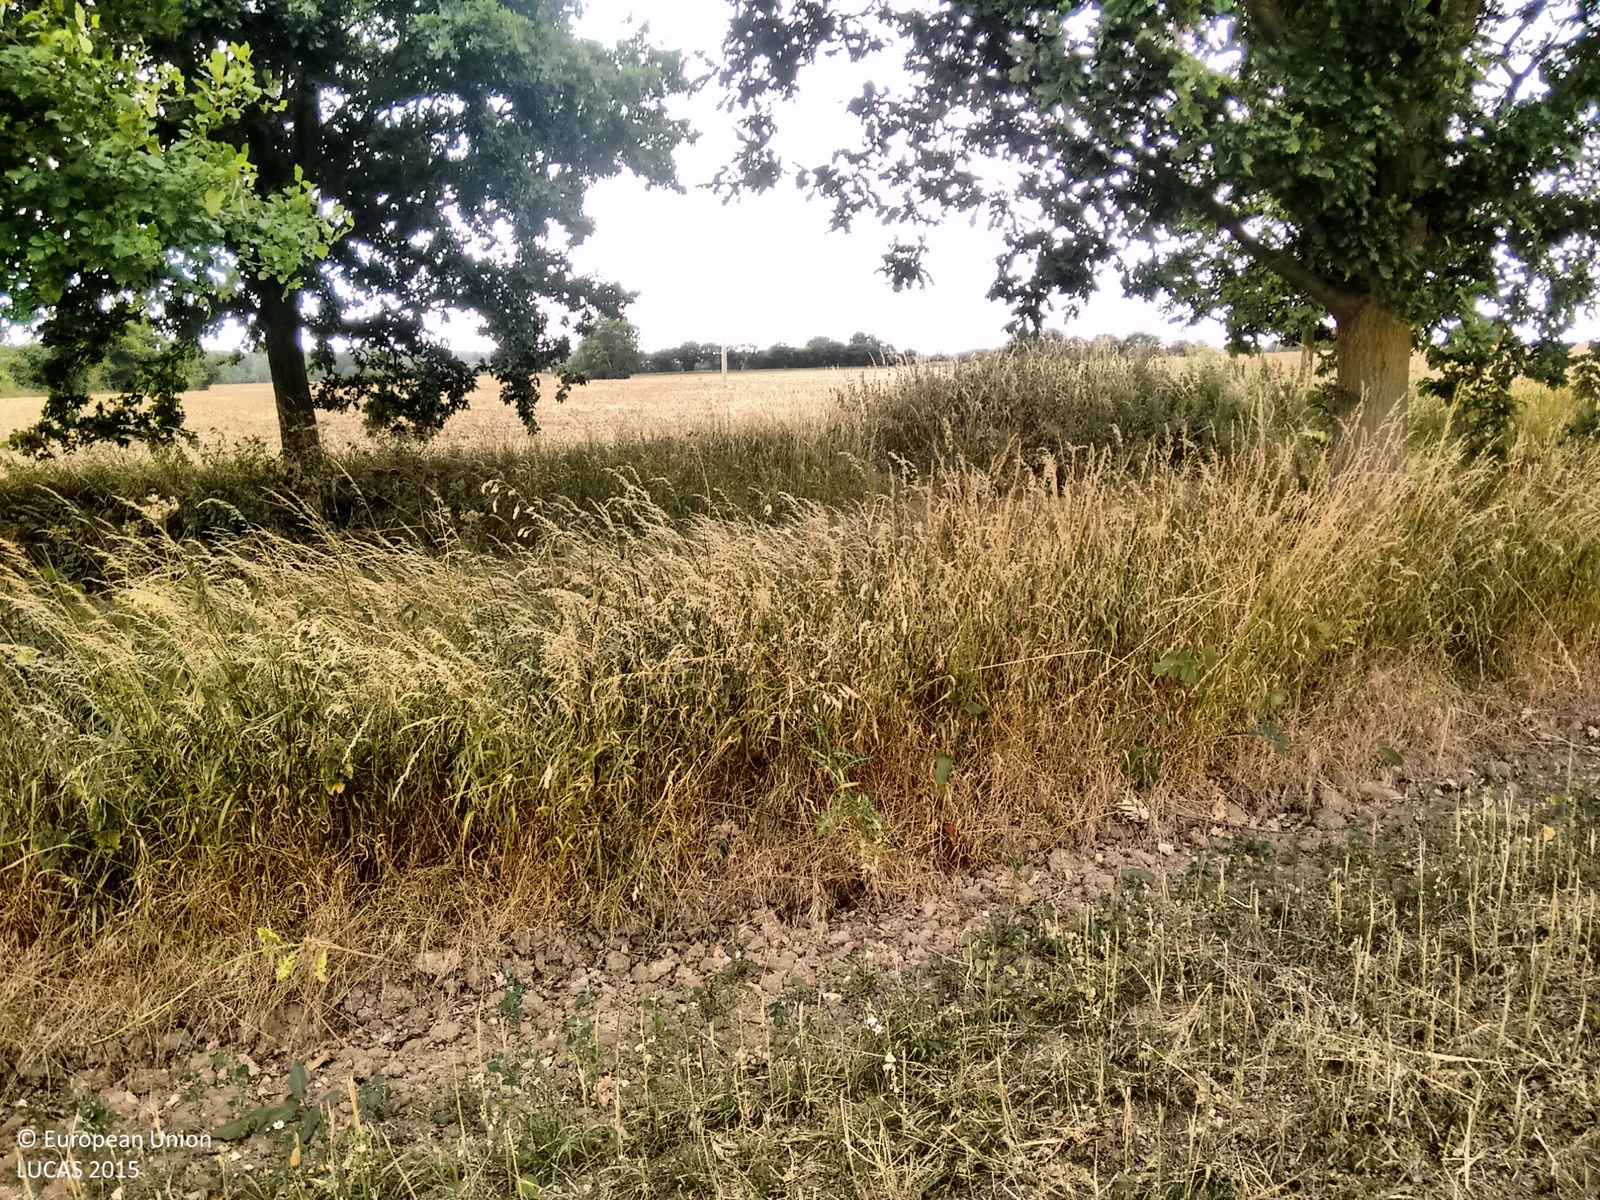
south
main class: Grassland
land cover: Spontaneously vegetated surfaces
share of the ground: 25 - 50 %
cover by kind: herbaceous plants 100 %
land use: Fallow land
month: July
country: GB
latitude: 51.8193
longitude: 0.5575
